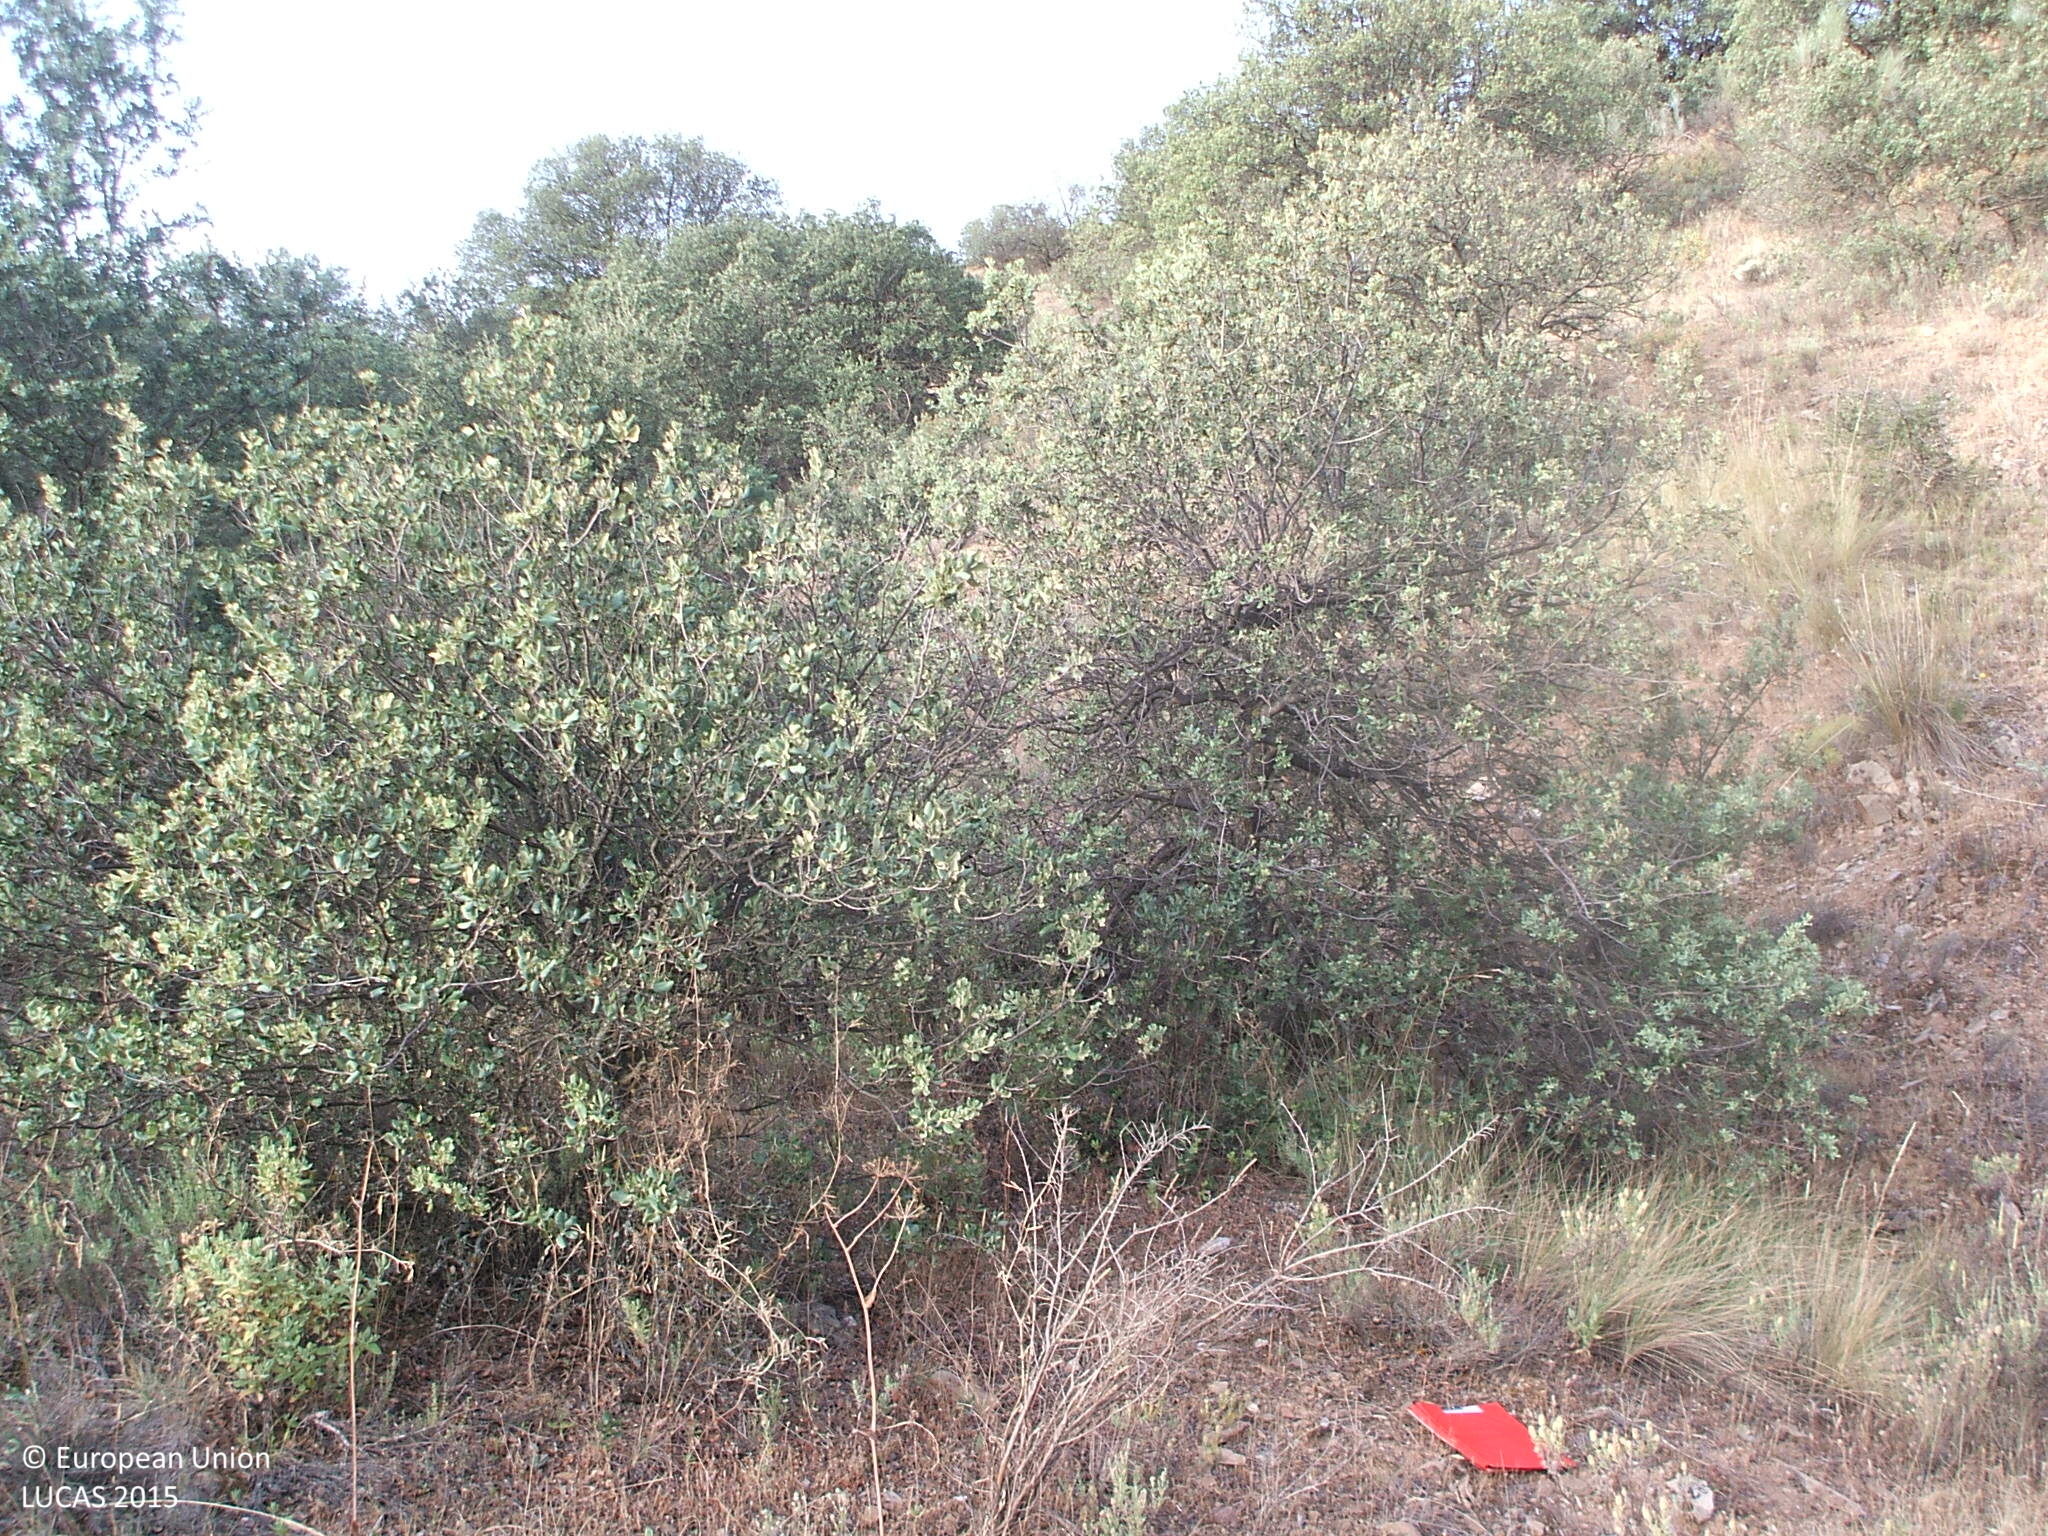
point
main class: Woodland
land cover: Broadleaved woodland
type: broadleaved evergreen forest
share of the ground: 50 - 75 %
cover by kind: broadleaved forest trees 60 %, herbaceous plants 20 %, lichens and mosses 20 %
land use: Semi-natural and natural areas not in use
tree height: < 5 m
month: July
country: ES
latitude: 37.2210
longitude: -2.2976
